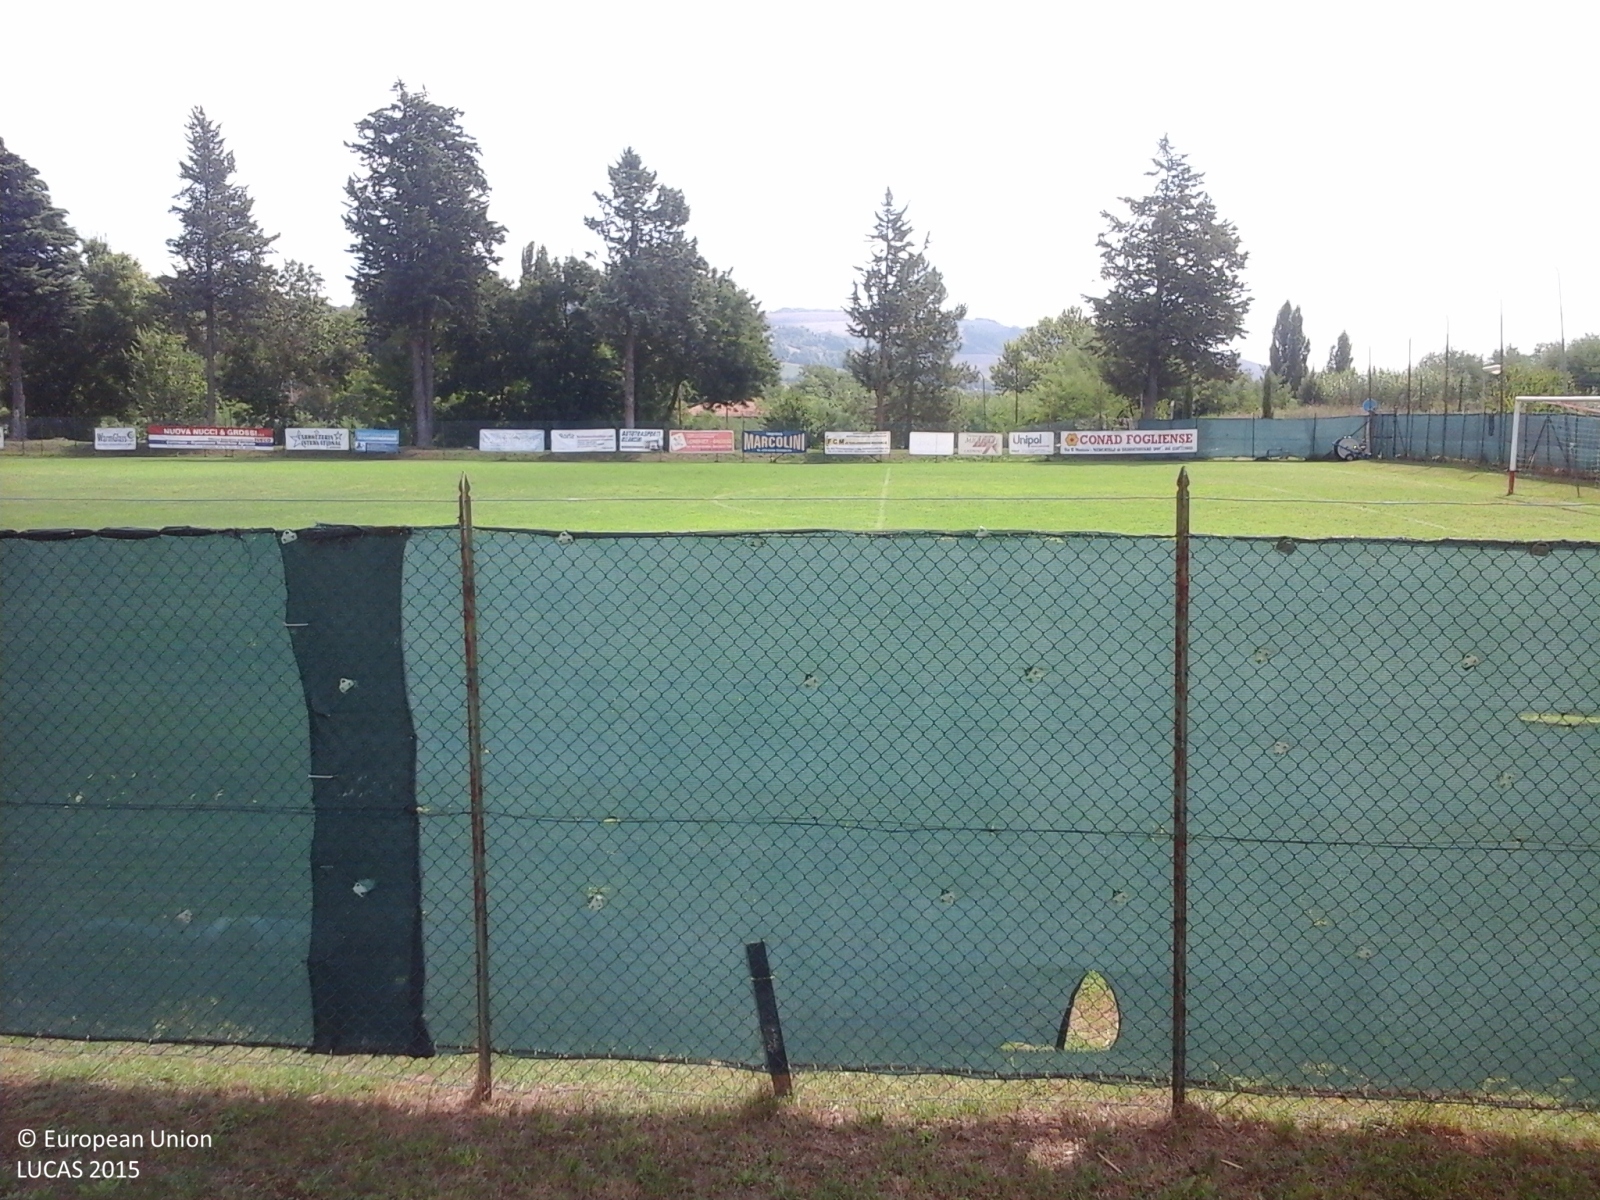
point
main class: Grassland
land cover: Grassland without tree/shrub cover
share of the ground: > 75 %
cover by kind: herbaceous plants 100 %
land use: Sport
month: August
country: IT
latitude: 43.8128
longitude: 12.5920
